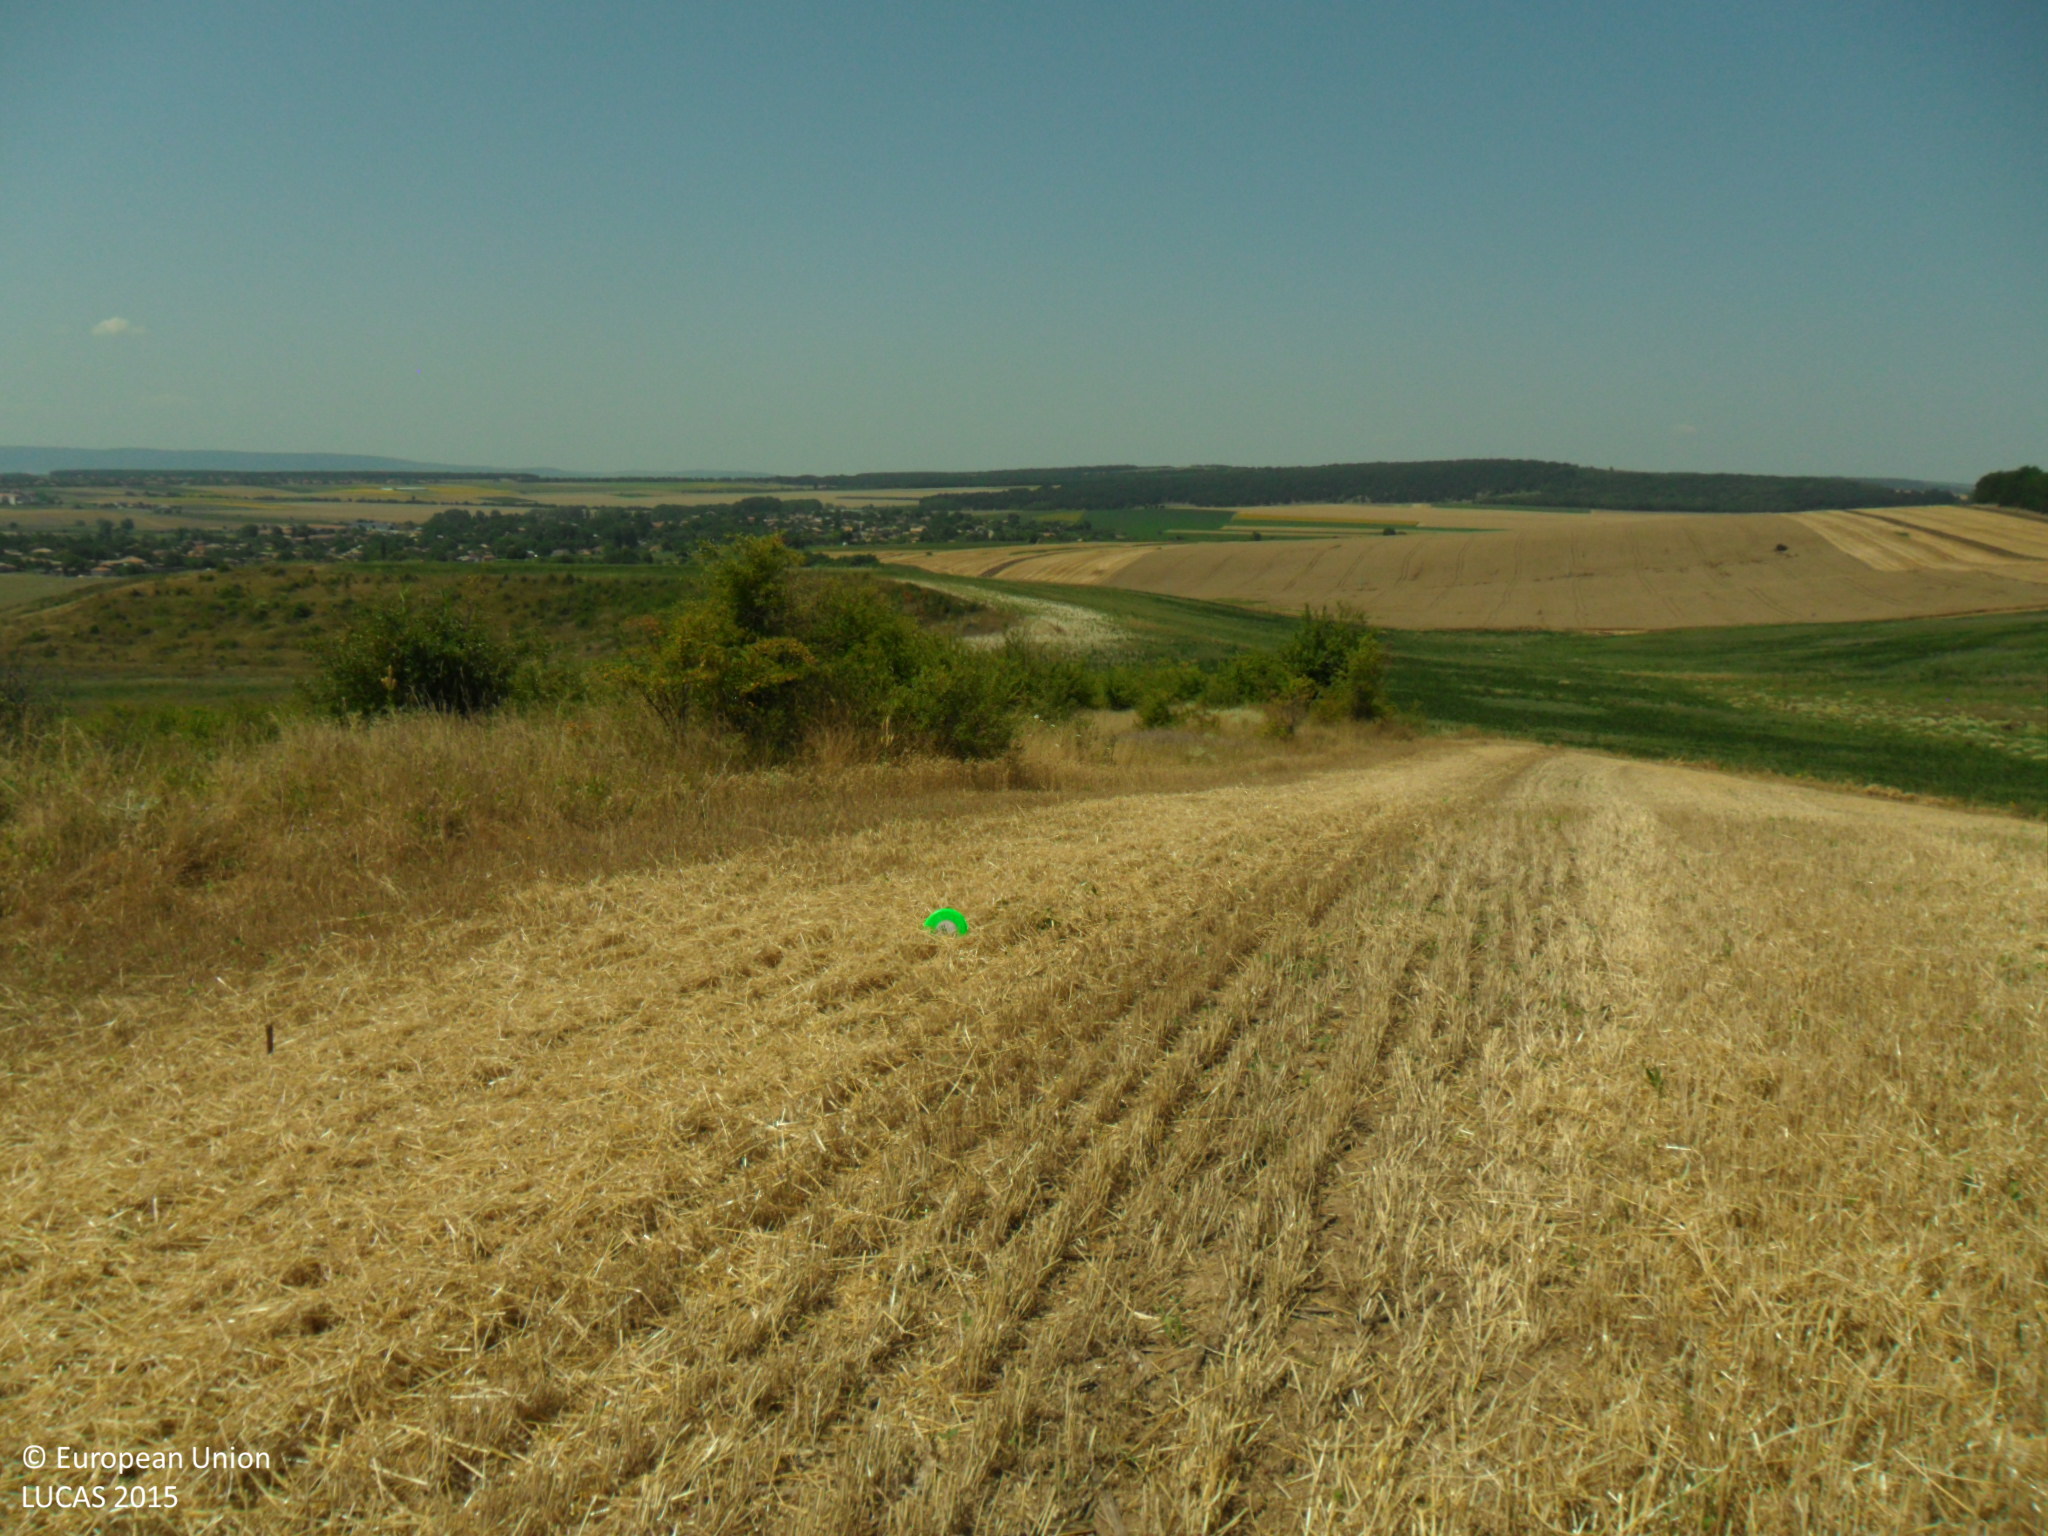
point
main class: Cropland
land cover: Common wheat
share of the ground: 50 - 75 %
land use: Agriculture (excluding fallow land and kitchen gardens)
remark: Harvested field
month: July
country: BG
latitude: 43.4001
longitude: 26.6397
